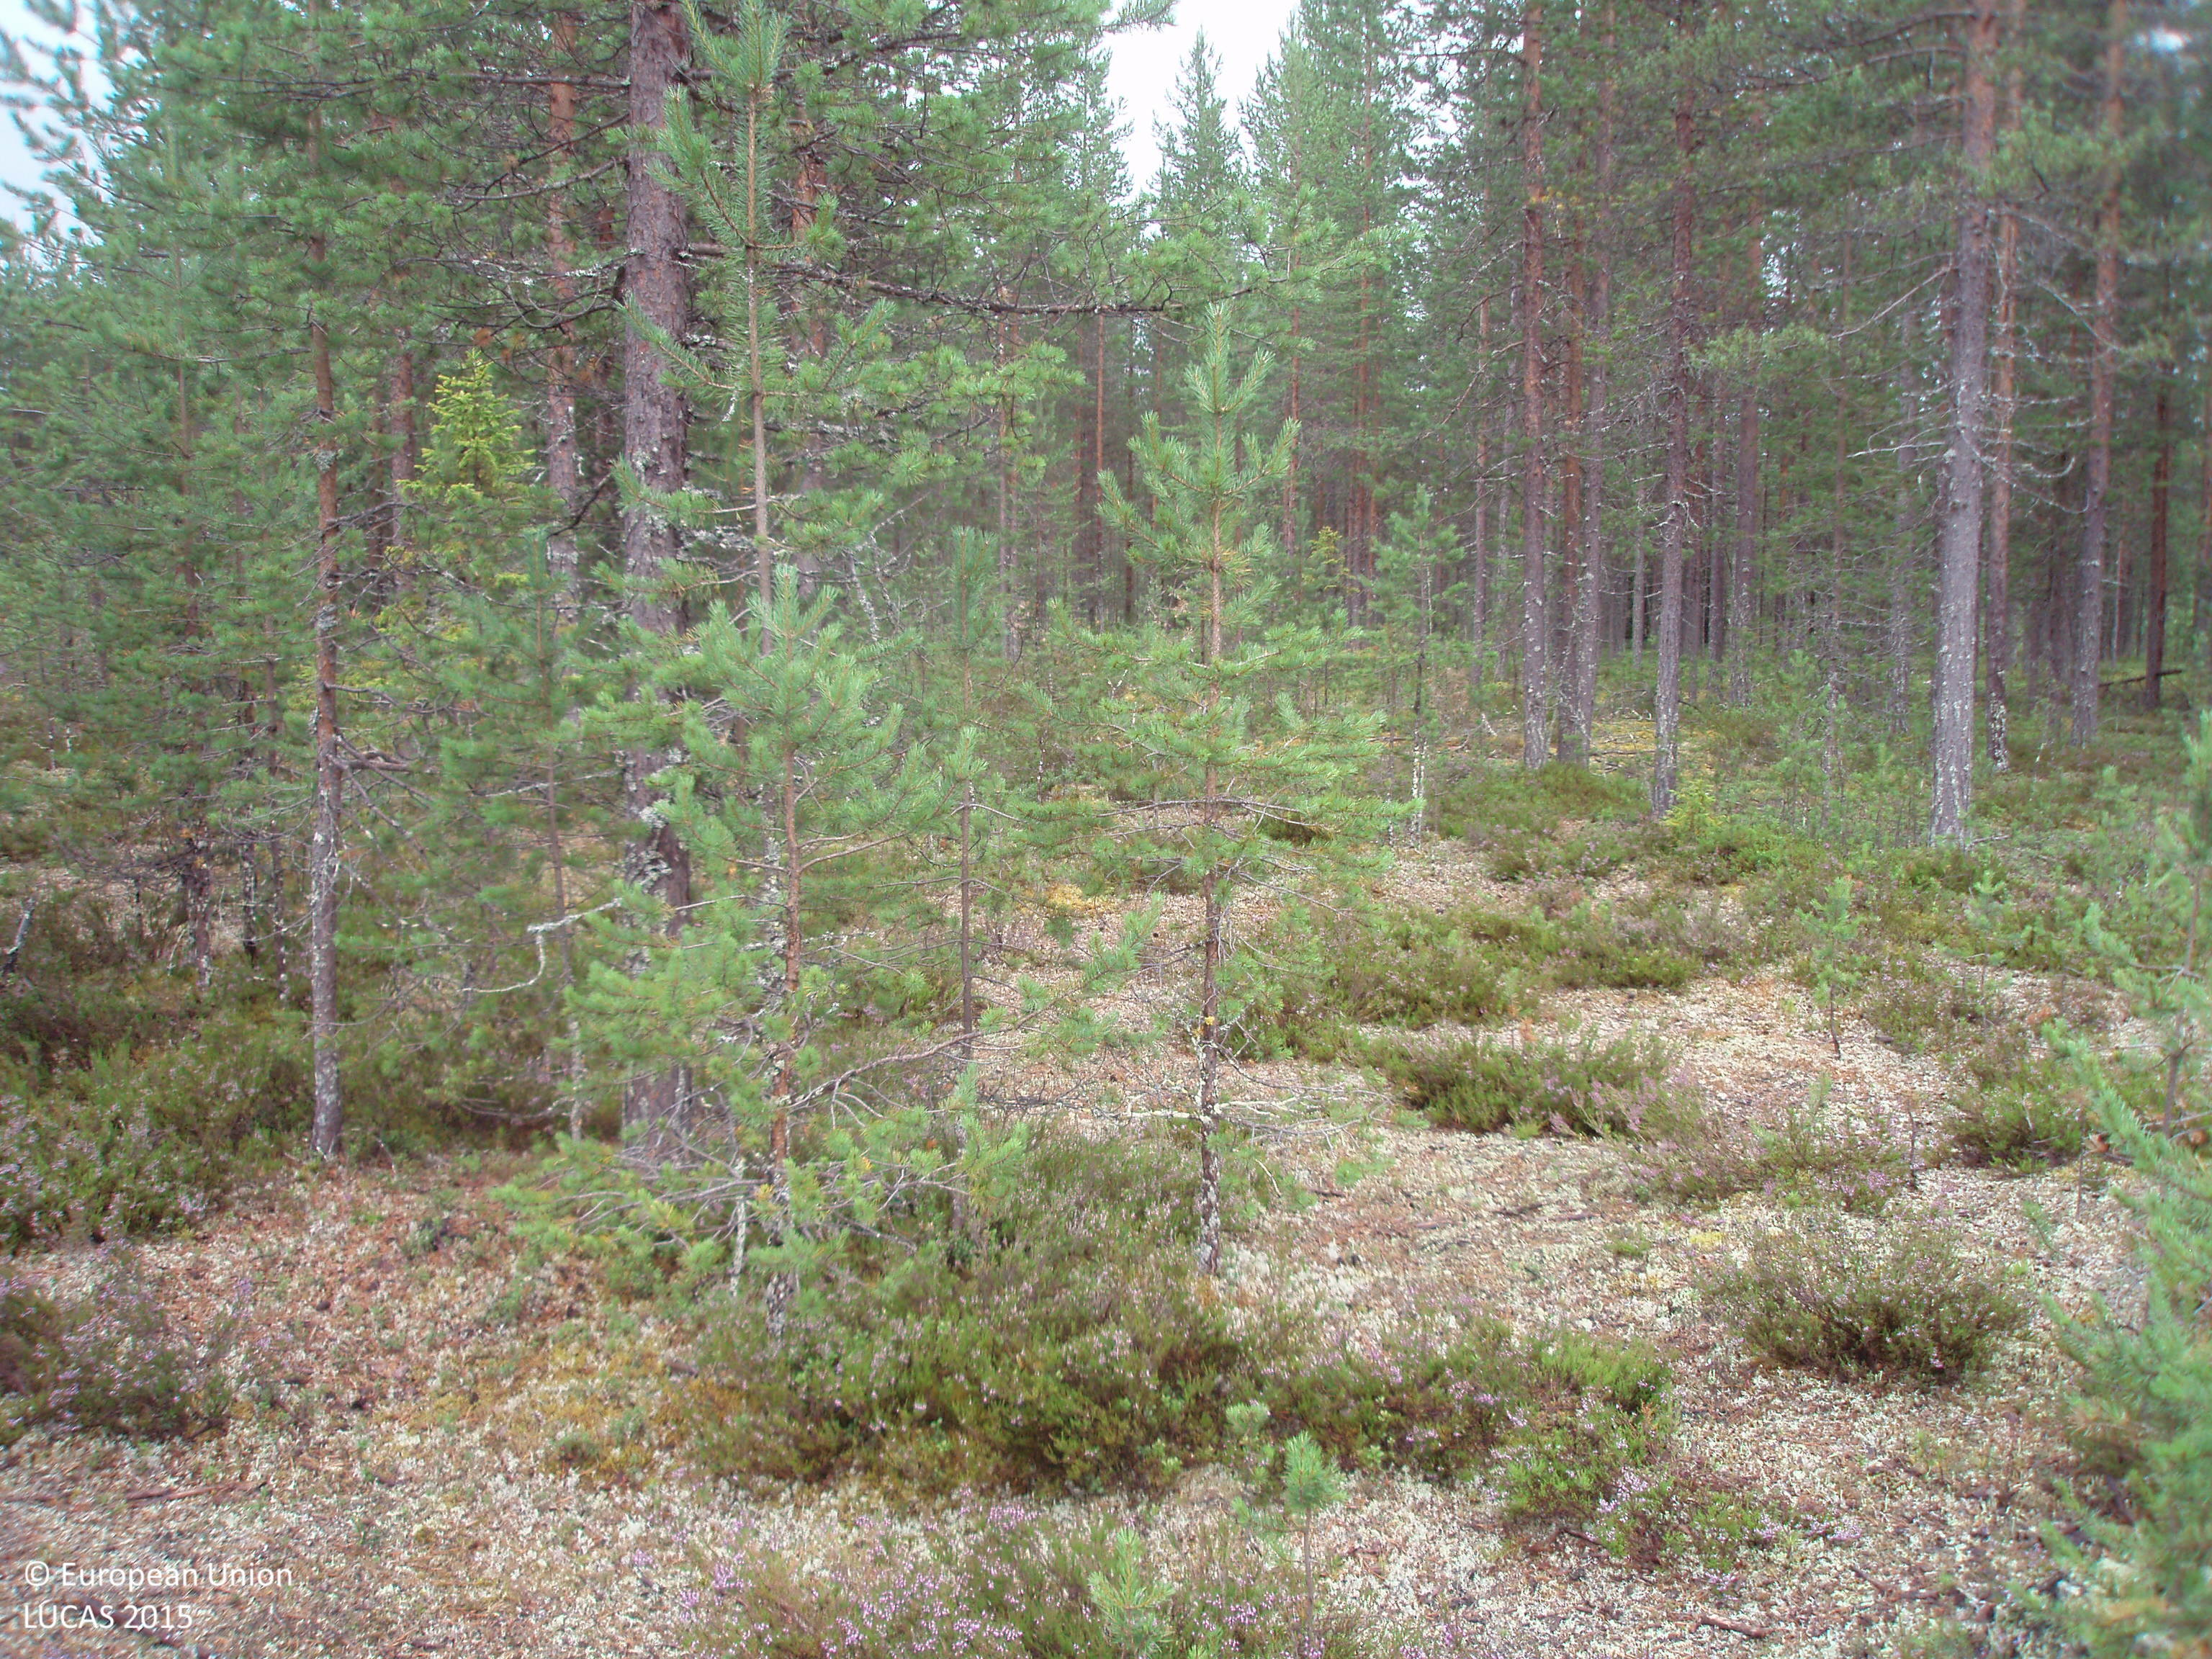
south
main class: Woodland
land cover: Pine dominated coniferous woodland
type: boreal forest
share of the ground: 25 - 50 %
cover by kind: shrubs 60 %, coniferous forest trees 40 %
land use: Forestry
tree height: < 5 m
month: August
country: FI
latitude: 65.5889
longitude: 27.0063
